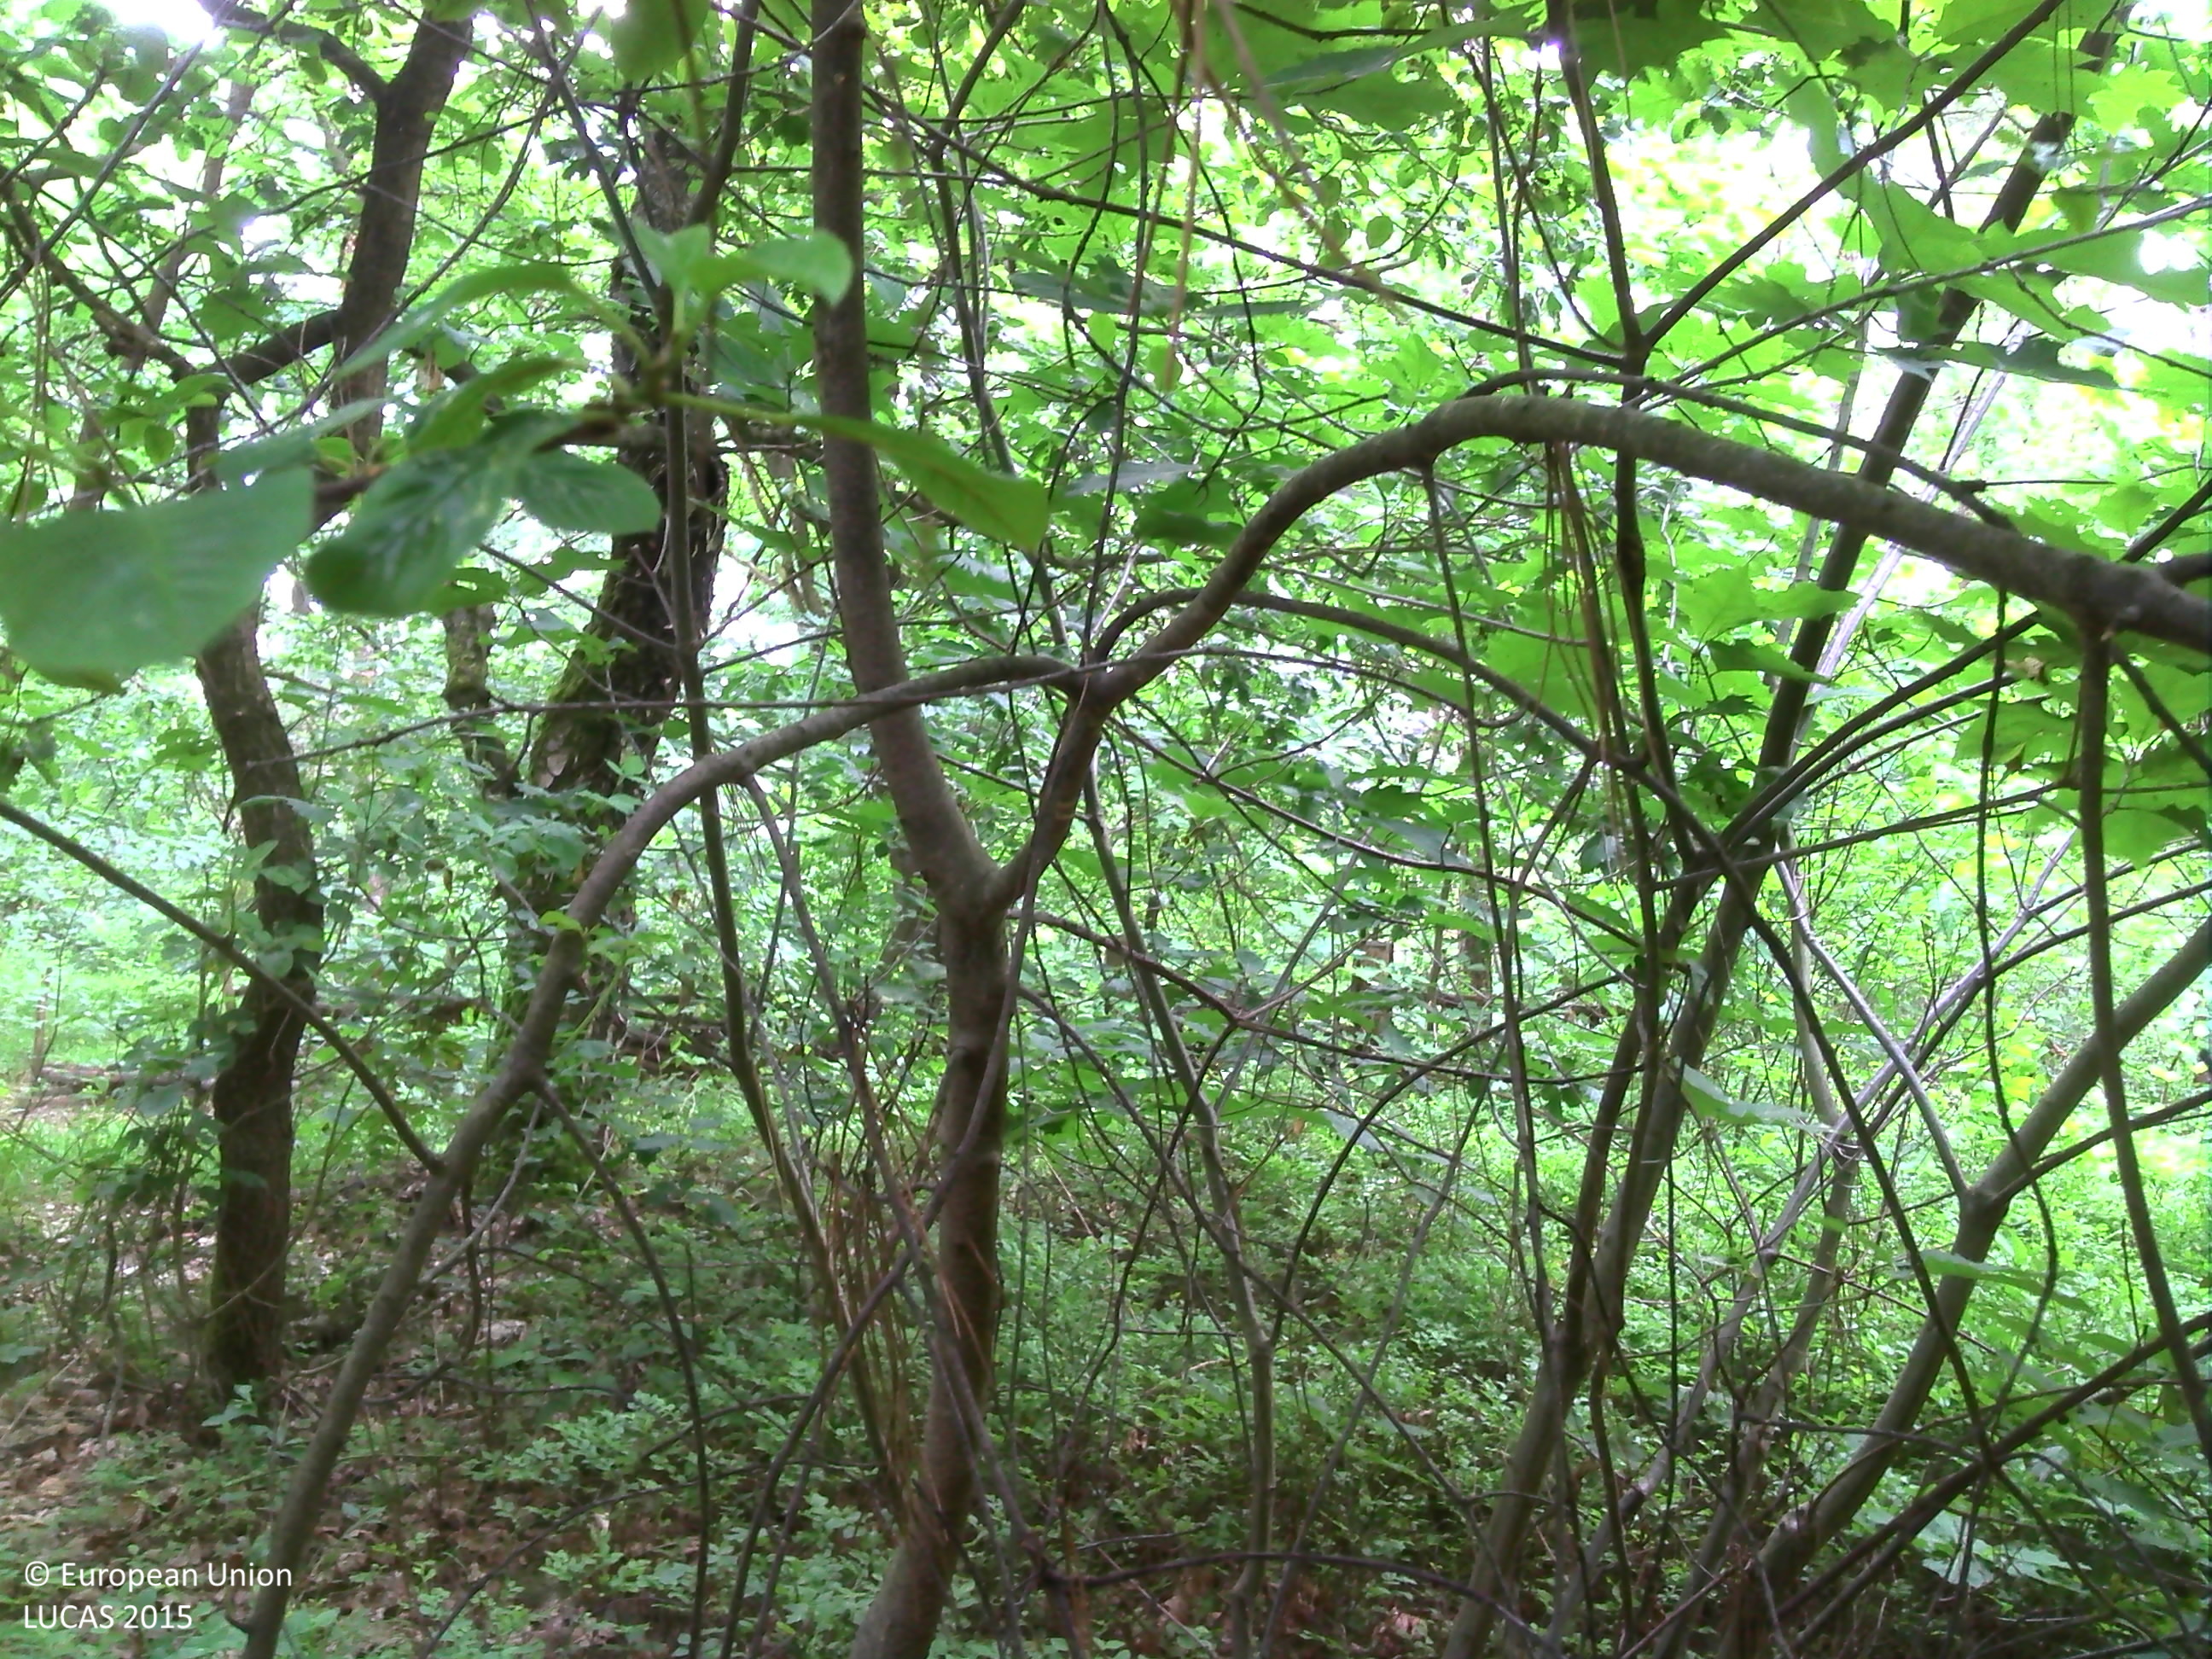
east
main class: Woodland
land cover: Pine dominated mixed woodland
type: acidophilous oak and oak-birch forest
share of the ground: > 75 %
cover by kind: broadleaved forest trees 70 %, coniferous forest trees 25 %, herbaceous plants 5 %
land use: Forestry
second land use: Sport
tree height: > 5 m
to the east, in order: Pine dominated mixed woodland; Tracks; Pine dominated mixed woodland; Tracks; Pine dominated mixed woodland
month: June
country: BE
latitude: 51.0207
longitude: 5.6789
